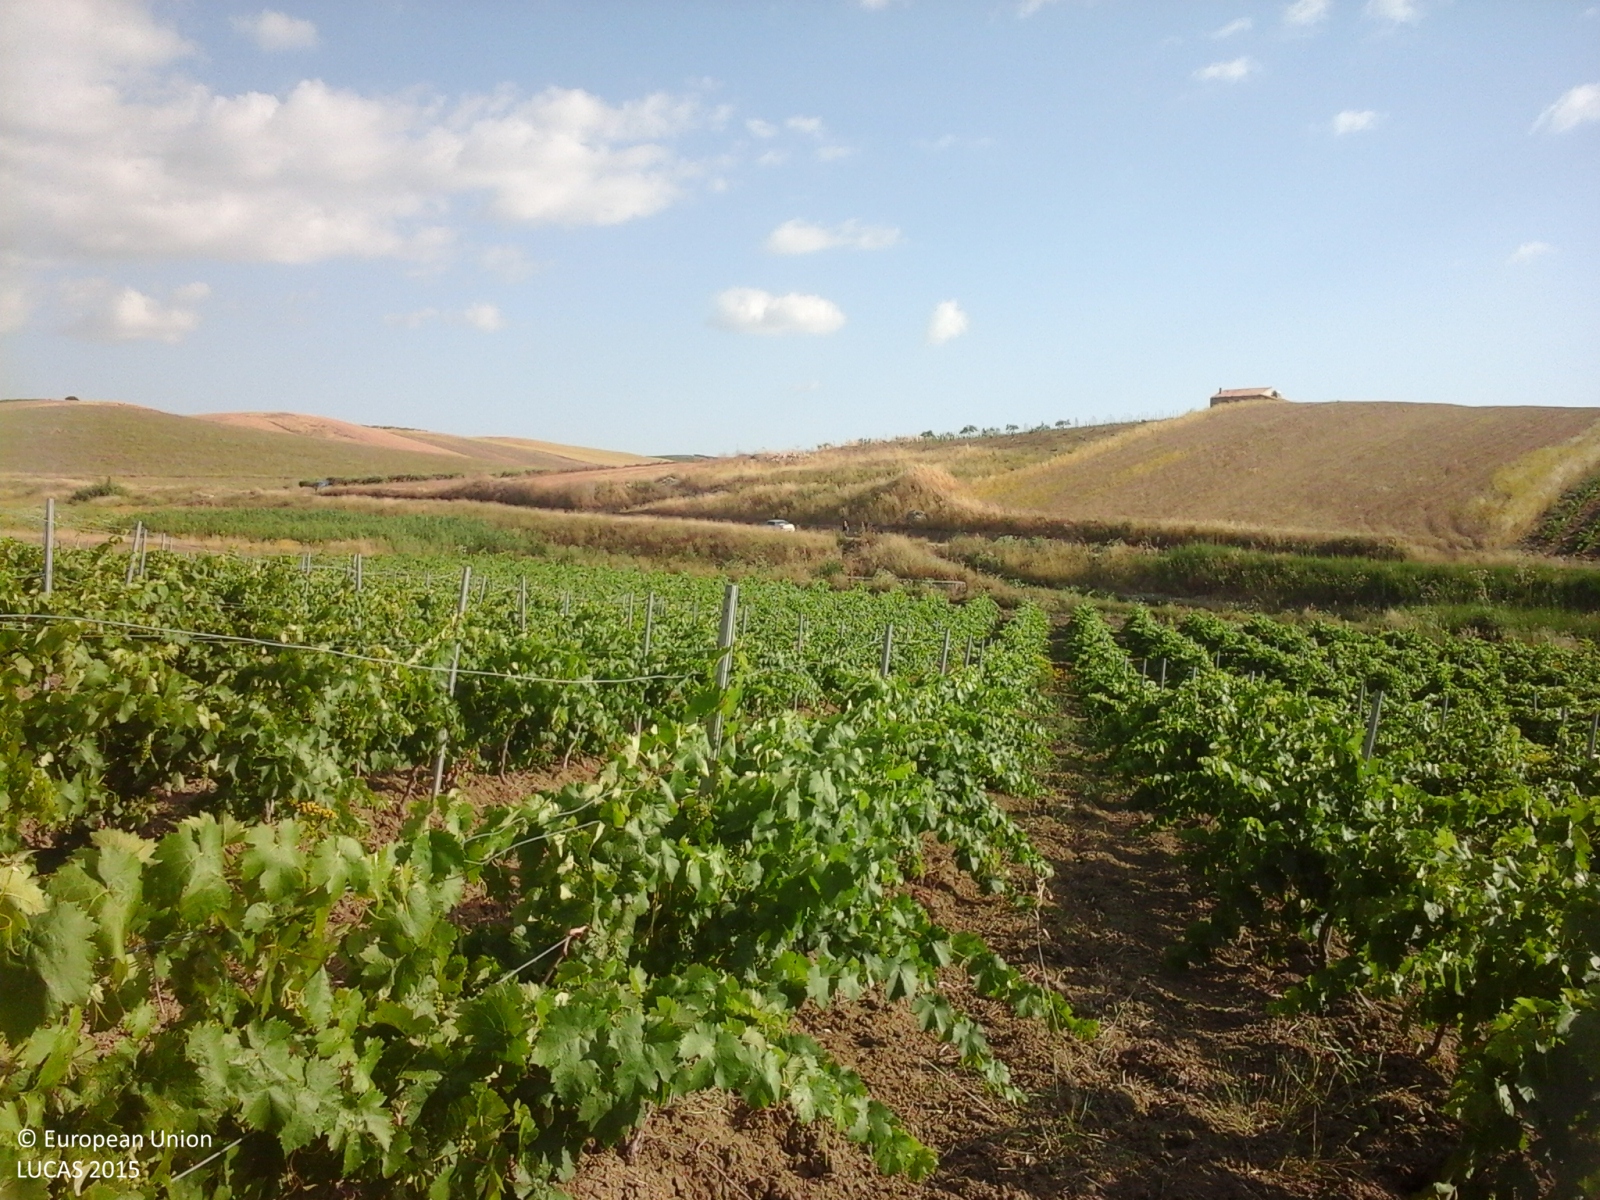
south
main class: Cropland
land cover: Vineyards
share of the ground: 25 - 50 %
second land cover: Other bare soil
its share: > 75 %
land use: Agriculture (excluding fallow land and kitchen gardens)
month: June
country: IT
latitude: 37.6979
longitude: 13.0732
